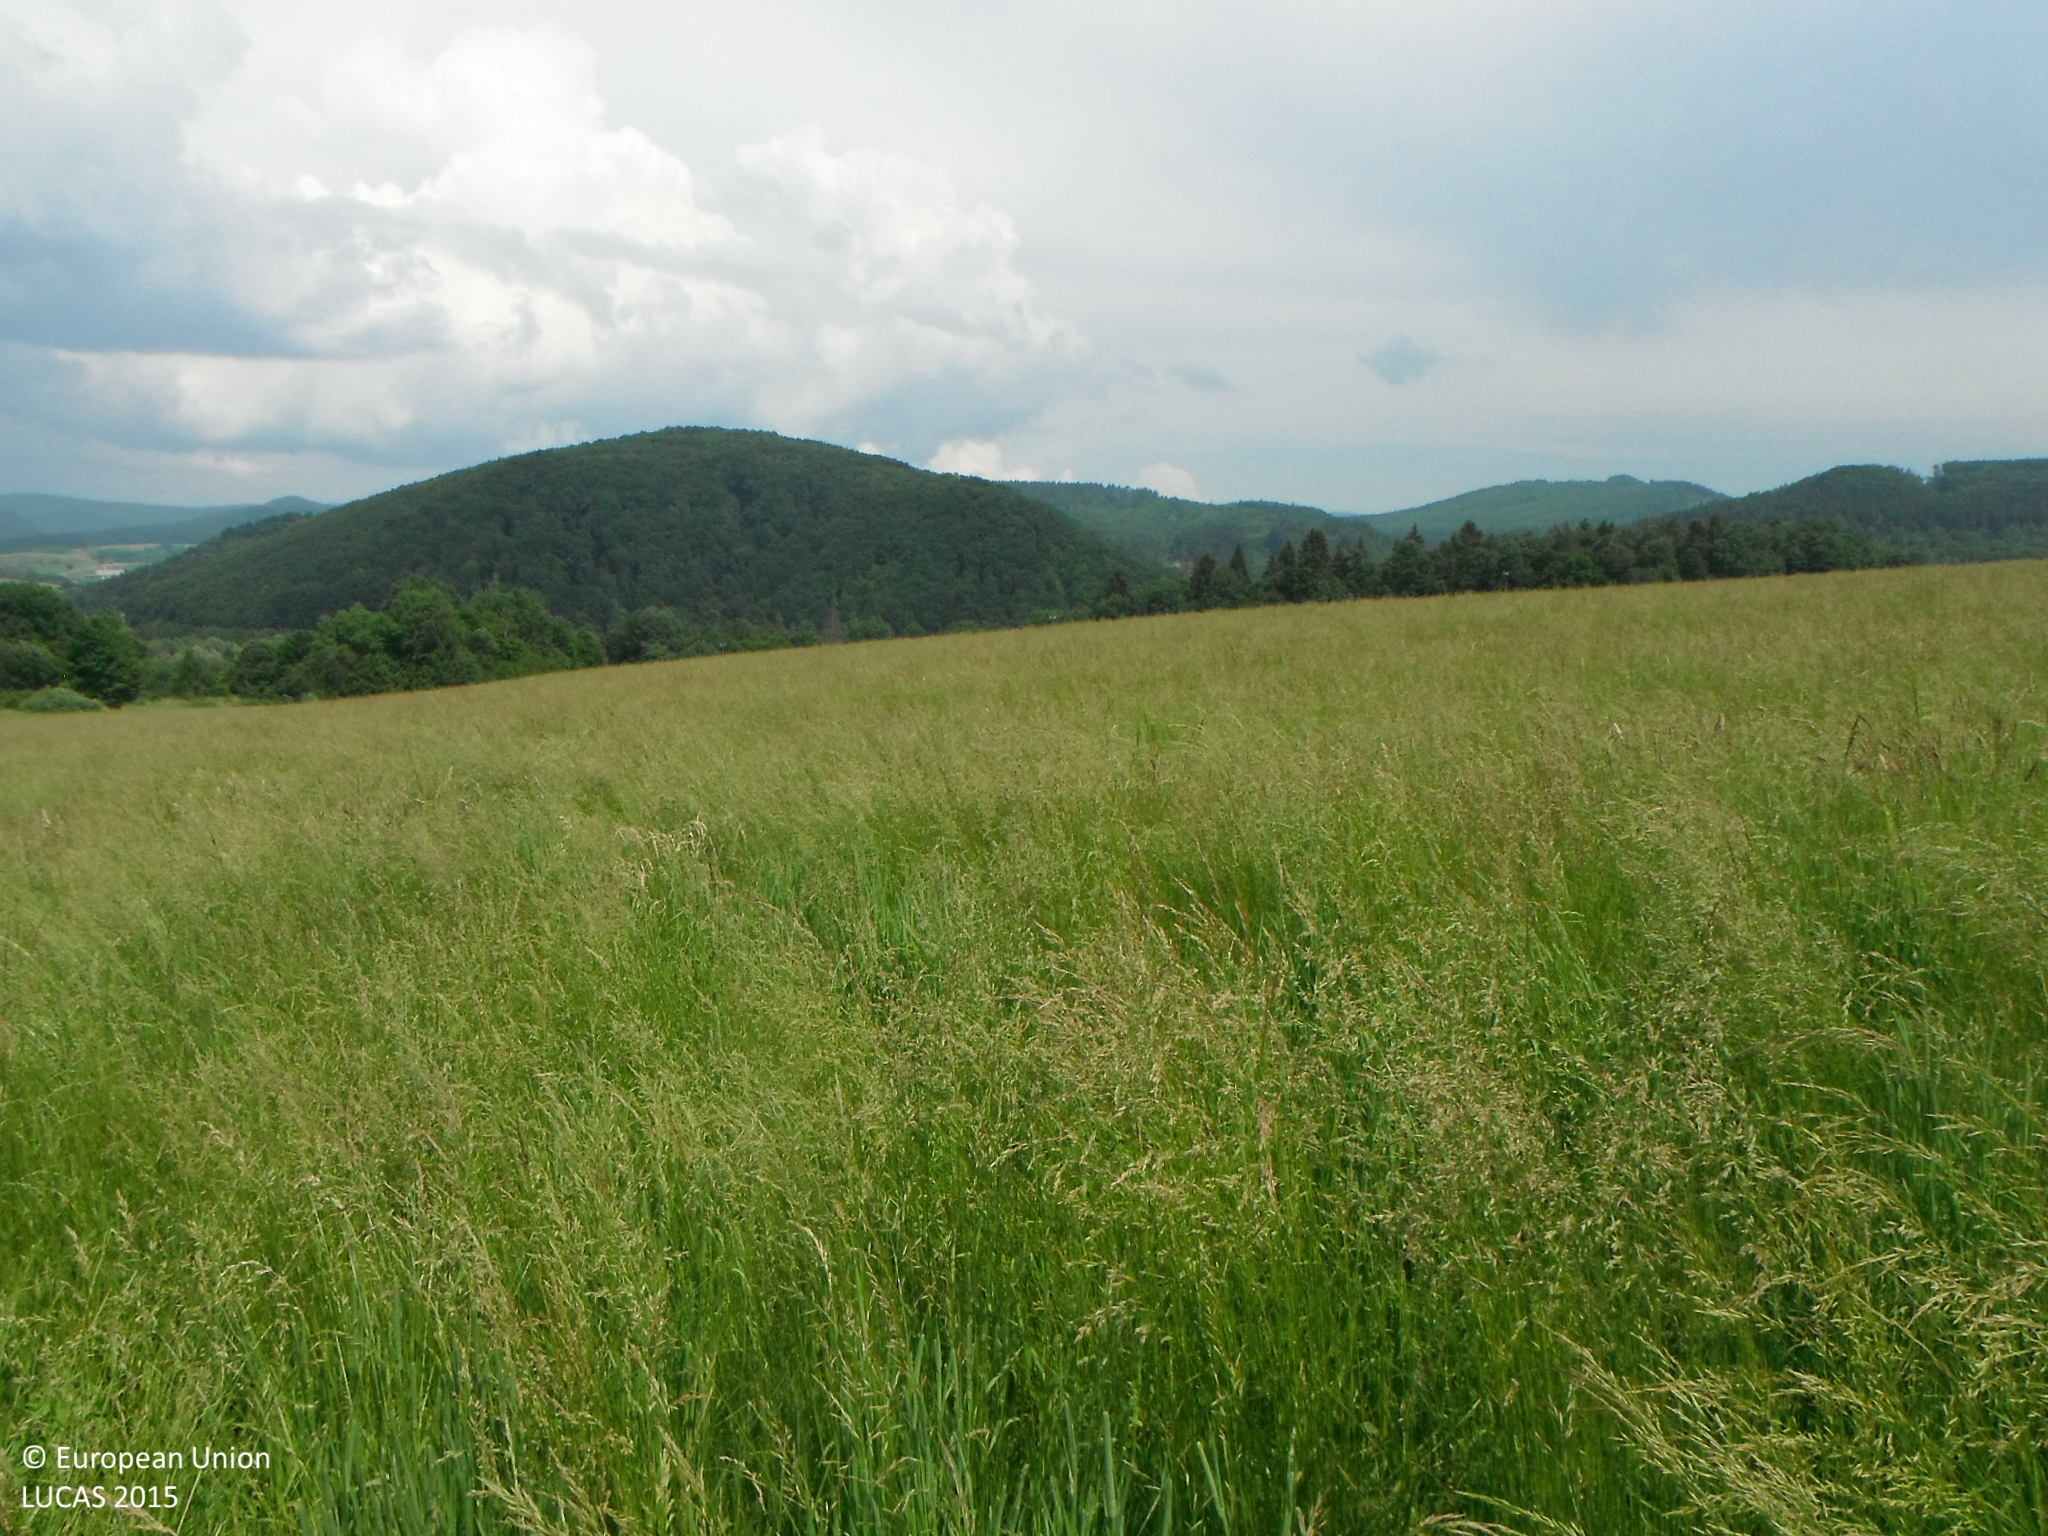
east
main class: Grassland
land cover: Grassland without tree/shrub cover
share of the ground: > 75 %
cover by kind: herbaceous plants 100 %
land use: Agriculture (excluding fallow land and kitchen gardens)
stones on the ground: < 10 %
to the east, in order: Grassland without tree/shrub cover; Tracks; Grassland without tree/shrub cover
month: June
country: SK
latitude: 48.6675
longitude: 19.2428
